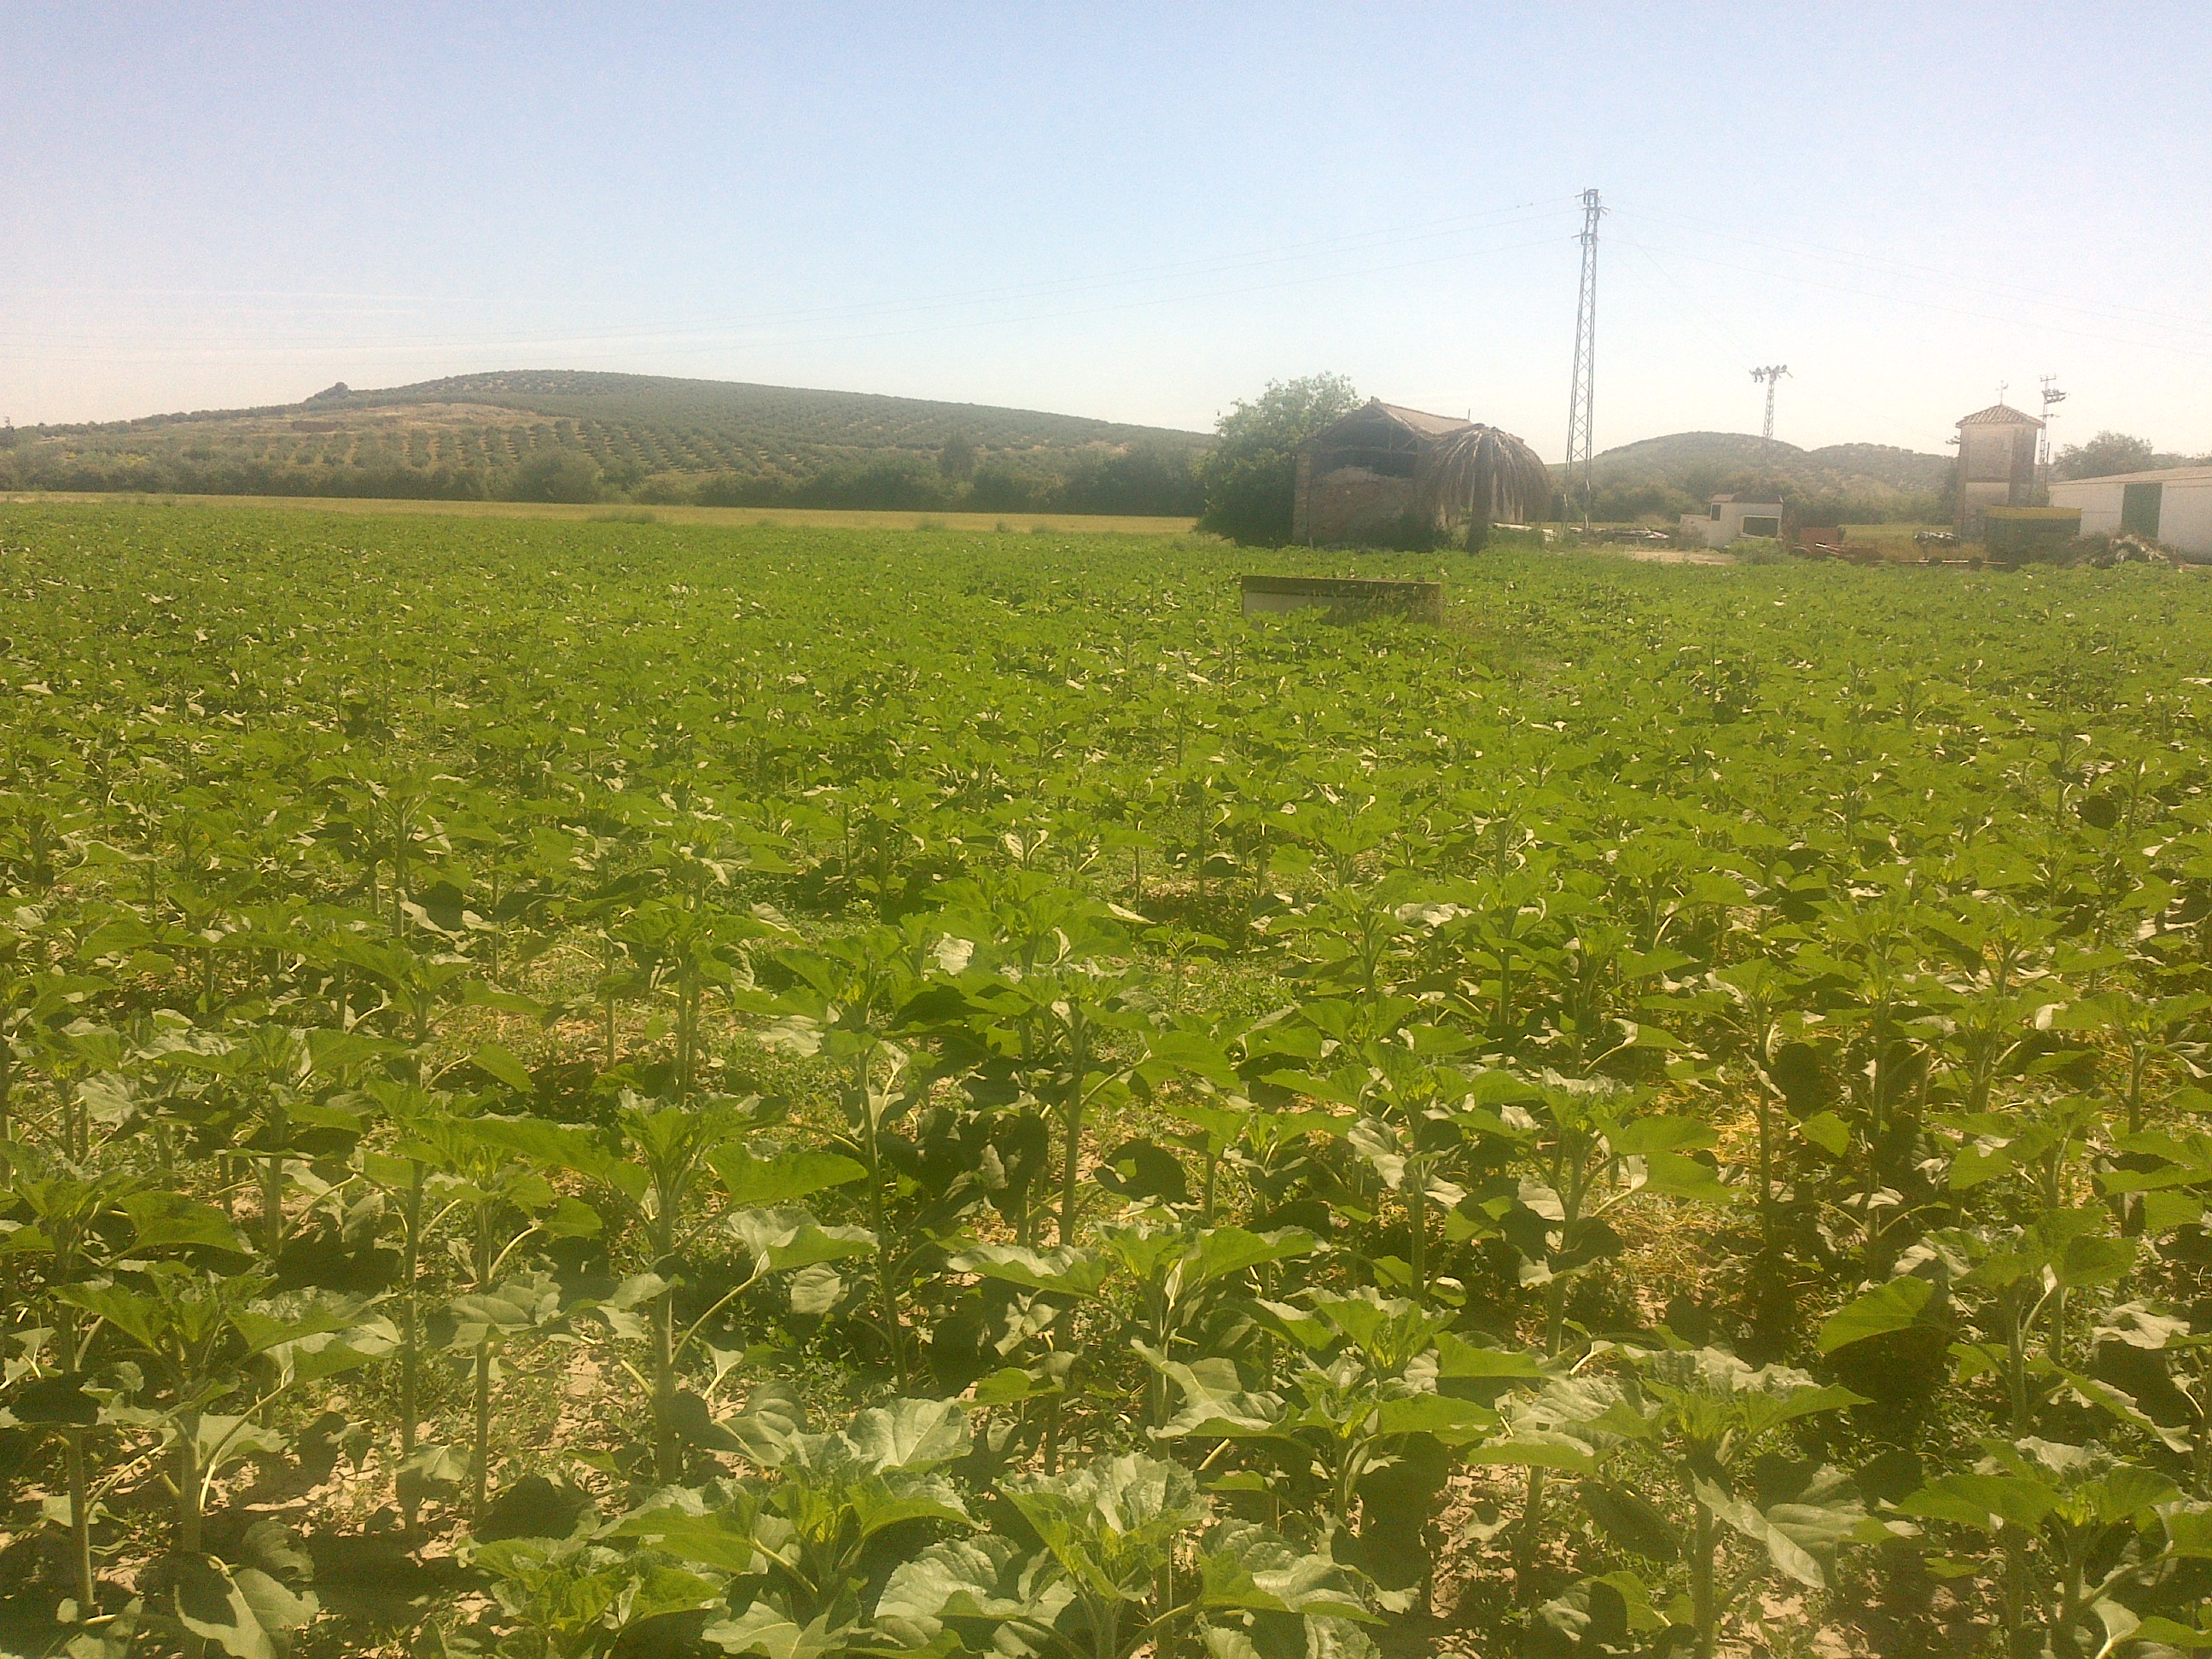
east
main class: Cropland
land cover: Sunflower
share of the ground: 50 - 75 %
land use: Agriculture (excluding fallow land and kitchen gardens)
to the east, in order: Sunflower; Artificial constructions in urban areas; Sunflower; Electric lines; Grass margins; Durum wheat
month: May
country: ES
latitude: 37.7441
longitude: -4.5466
